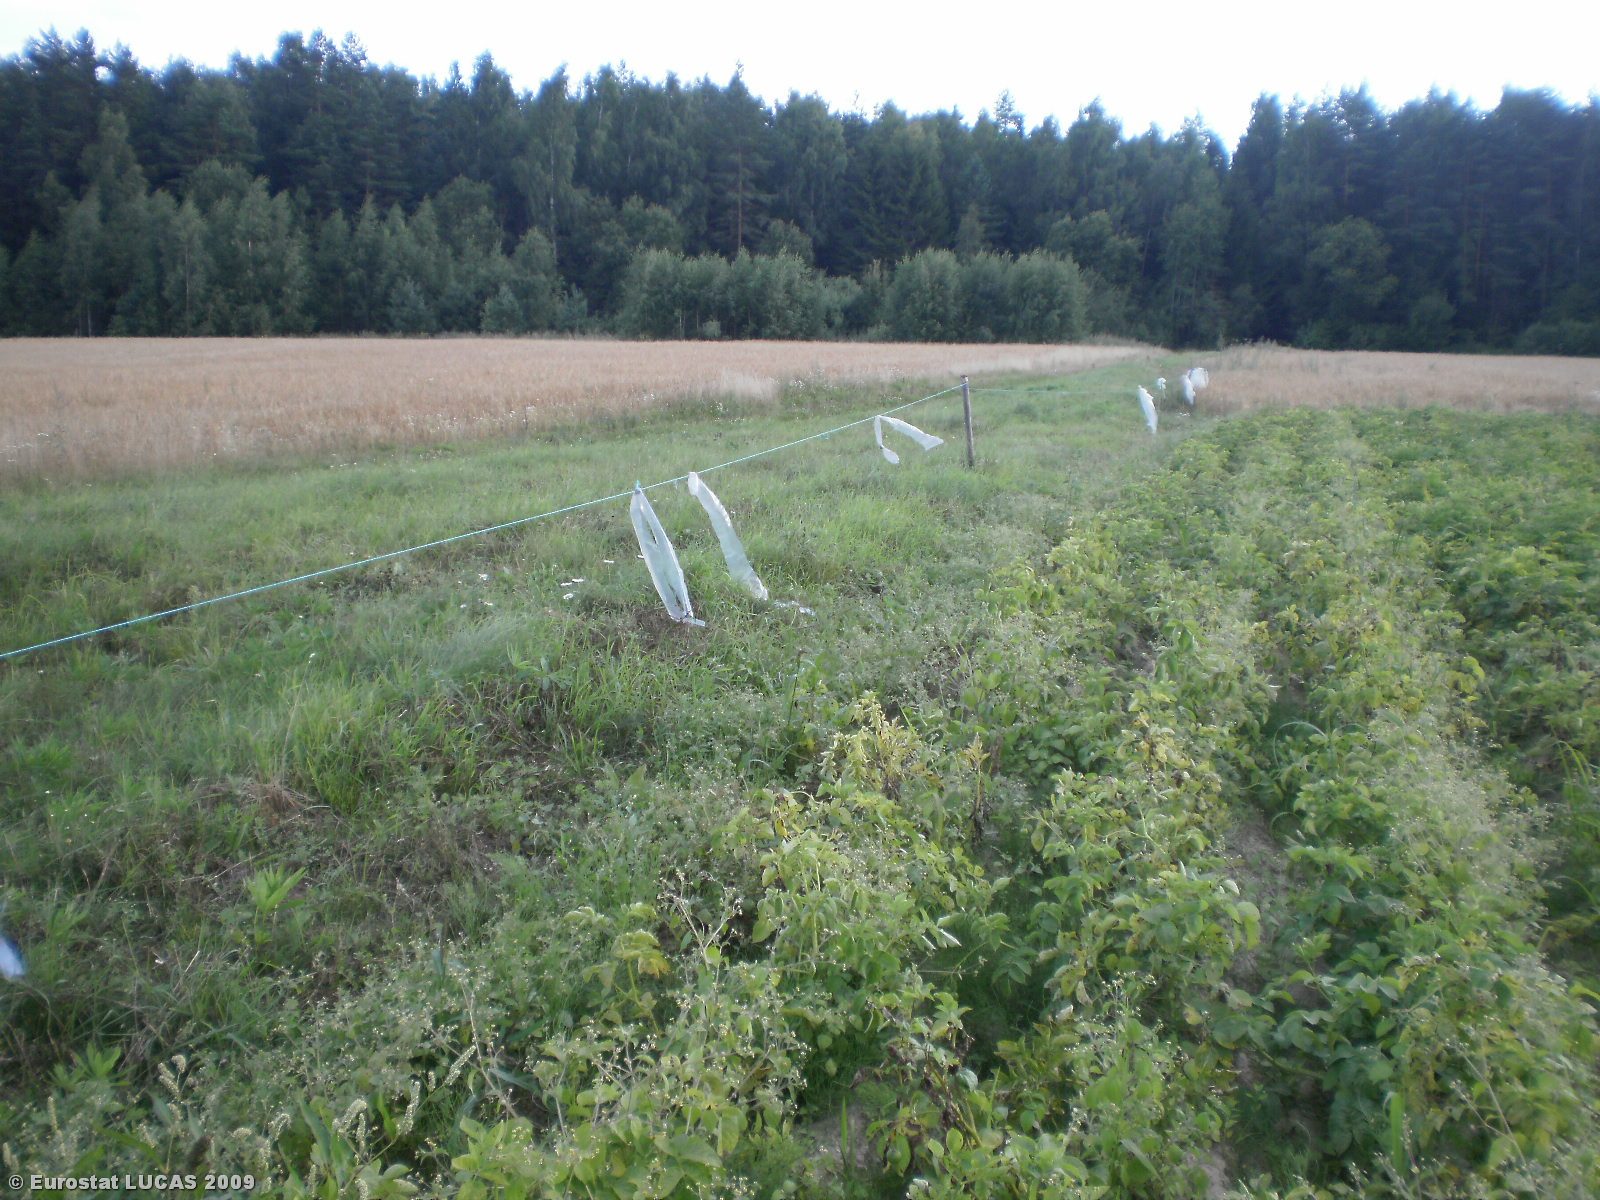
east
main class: Cropland
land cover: Potatoes
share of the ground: > 75 %
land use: Kitchen garden
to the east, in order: Potatoes; Tracks; Barley; Strawberries; Spontaneously vegetated surfaces
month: August
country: LT
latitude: 55.3804
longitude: 24.9306
